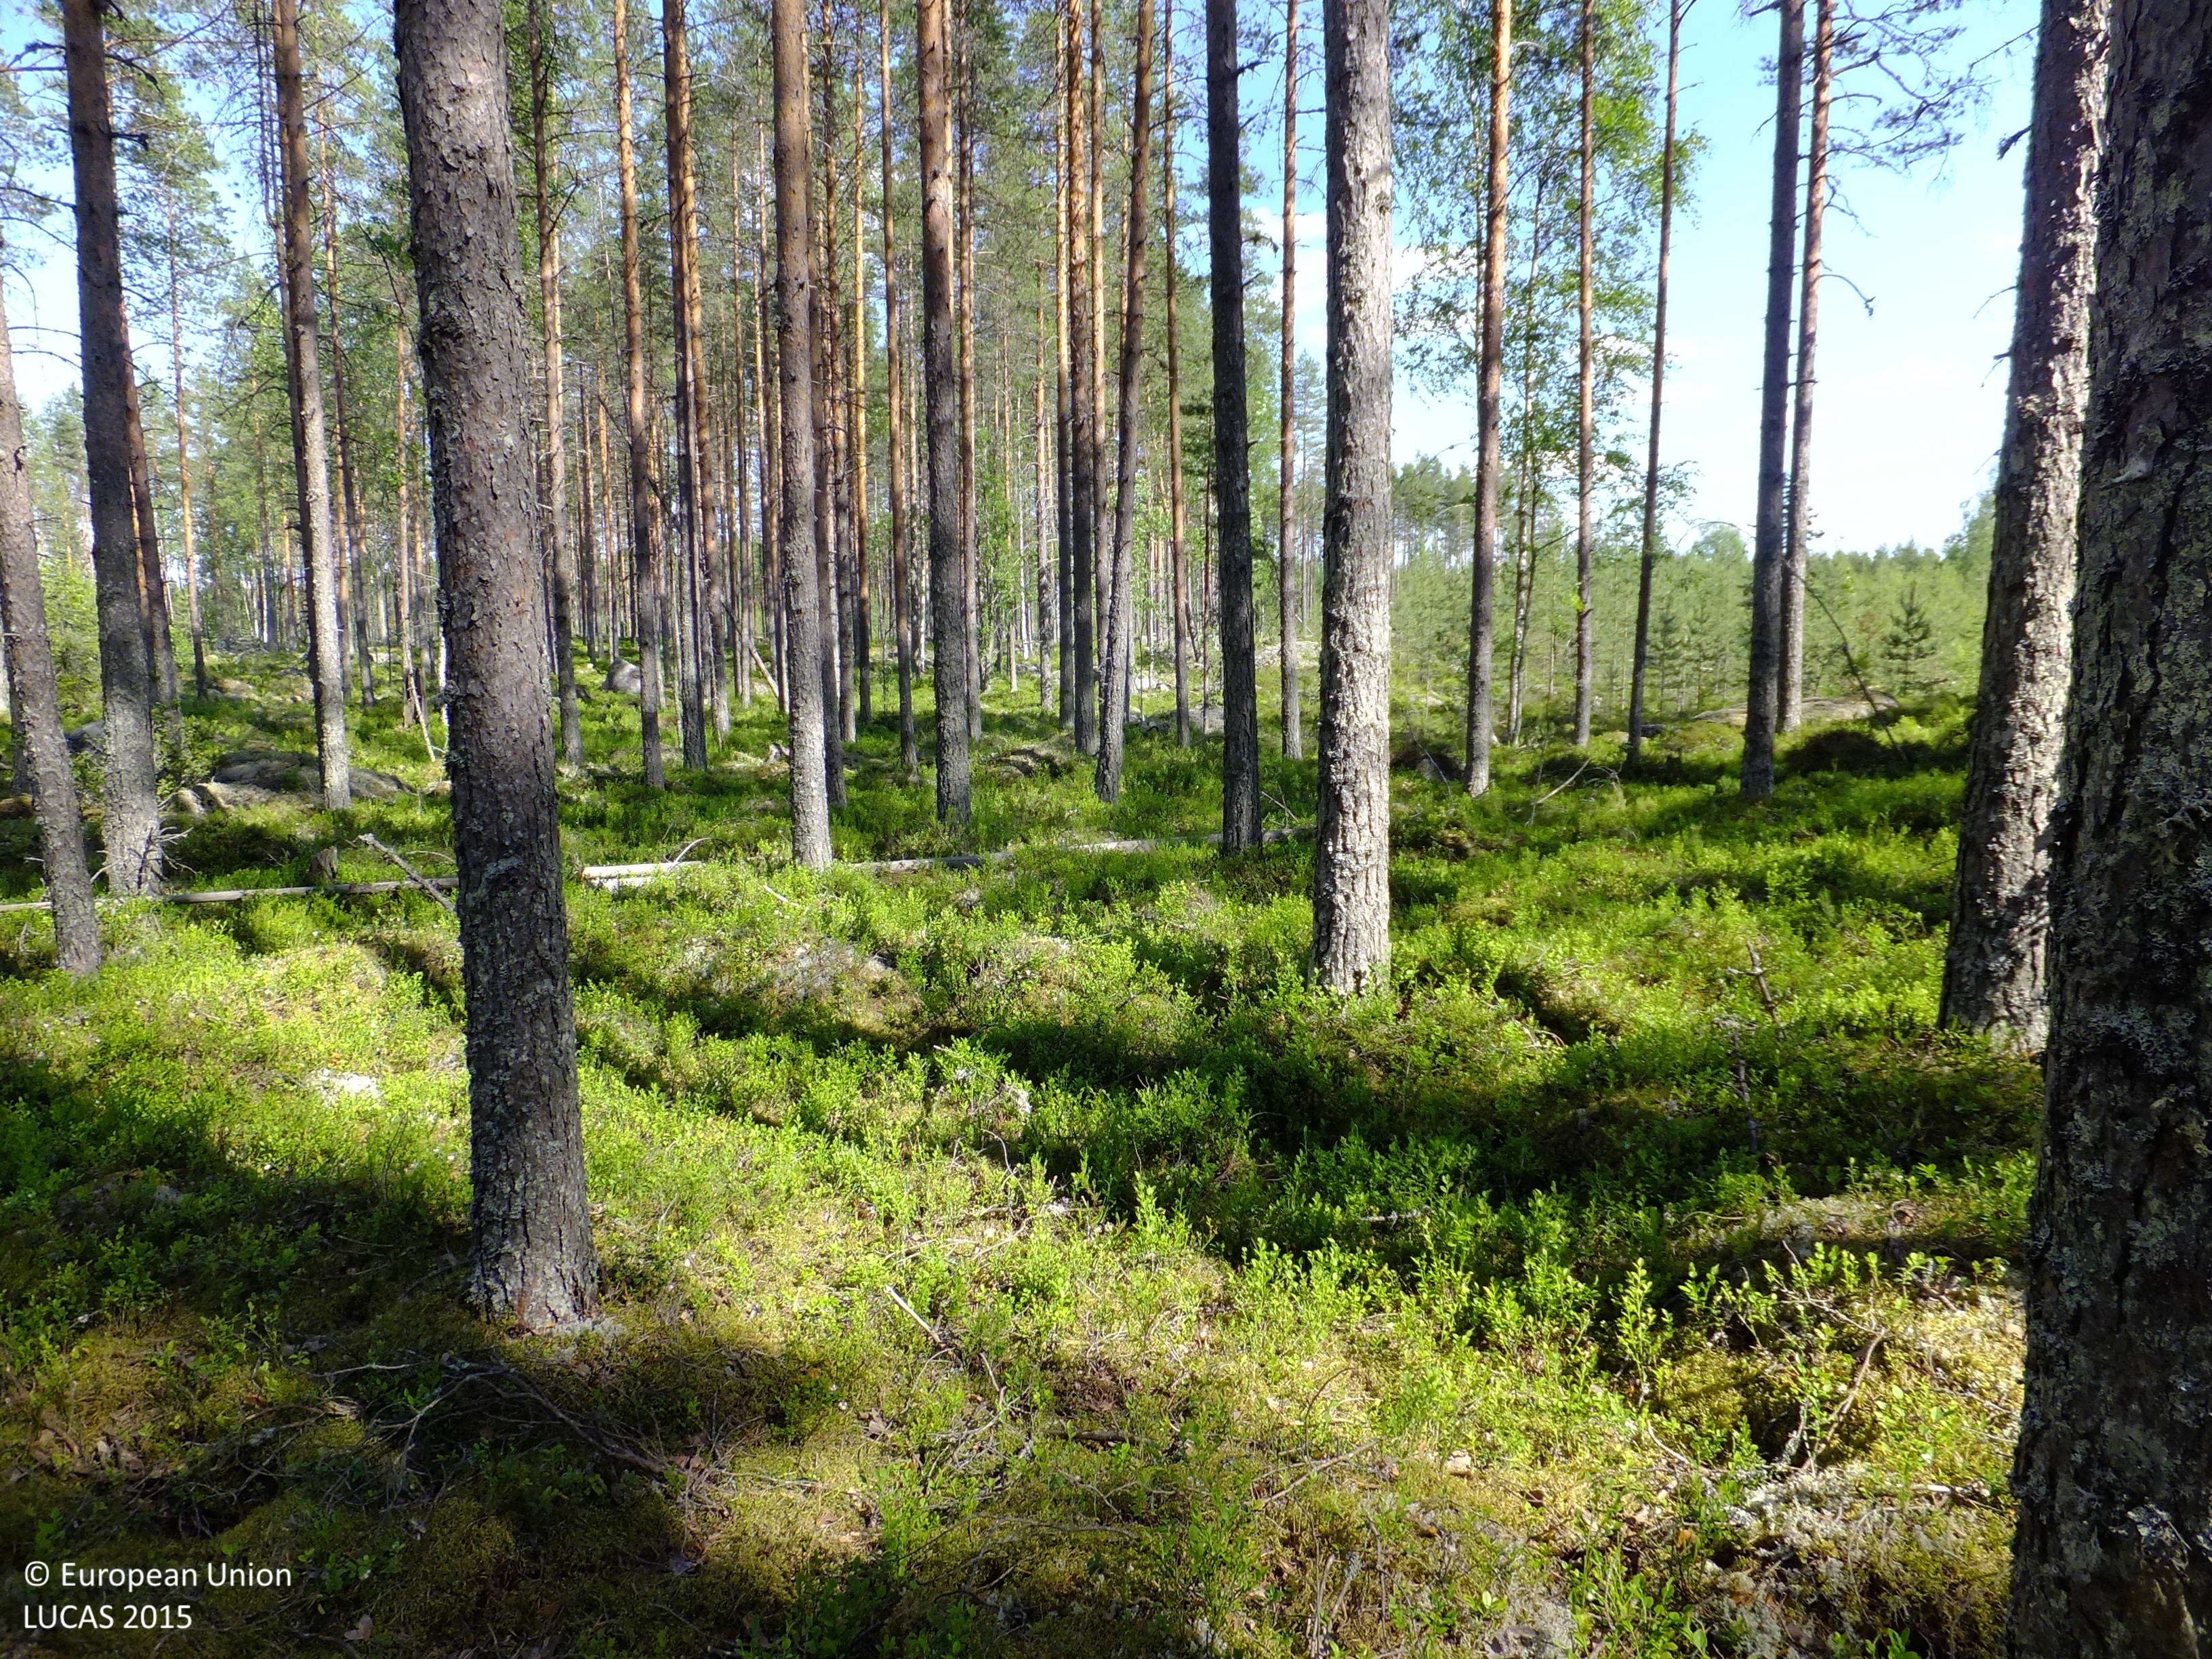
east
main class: Woodland
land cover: Pine dominated coniferous woodland
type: boreal forest
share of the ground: > 75 %
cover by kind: coniferous forest trees 80 %, broadleaved forest trees 5 %, shrubs 5 %, lichens and mosses 5 %, consolidated bare surface 5 %
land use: Forestry
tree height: > 5 m
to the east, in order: Pine dominated coniferous woodland; Pine dominated mixed woodland
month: July
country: FI
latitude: 63.3007
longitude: 24.9125
